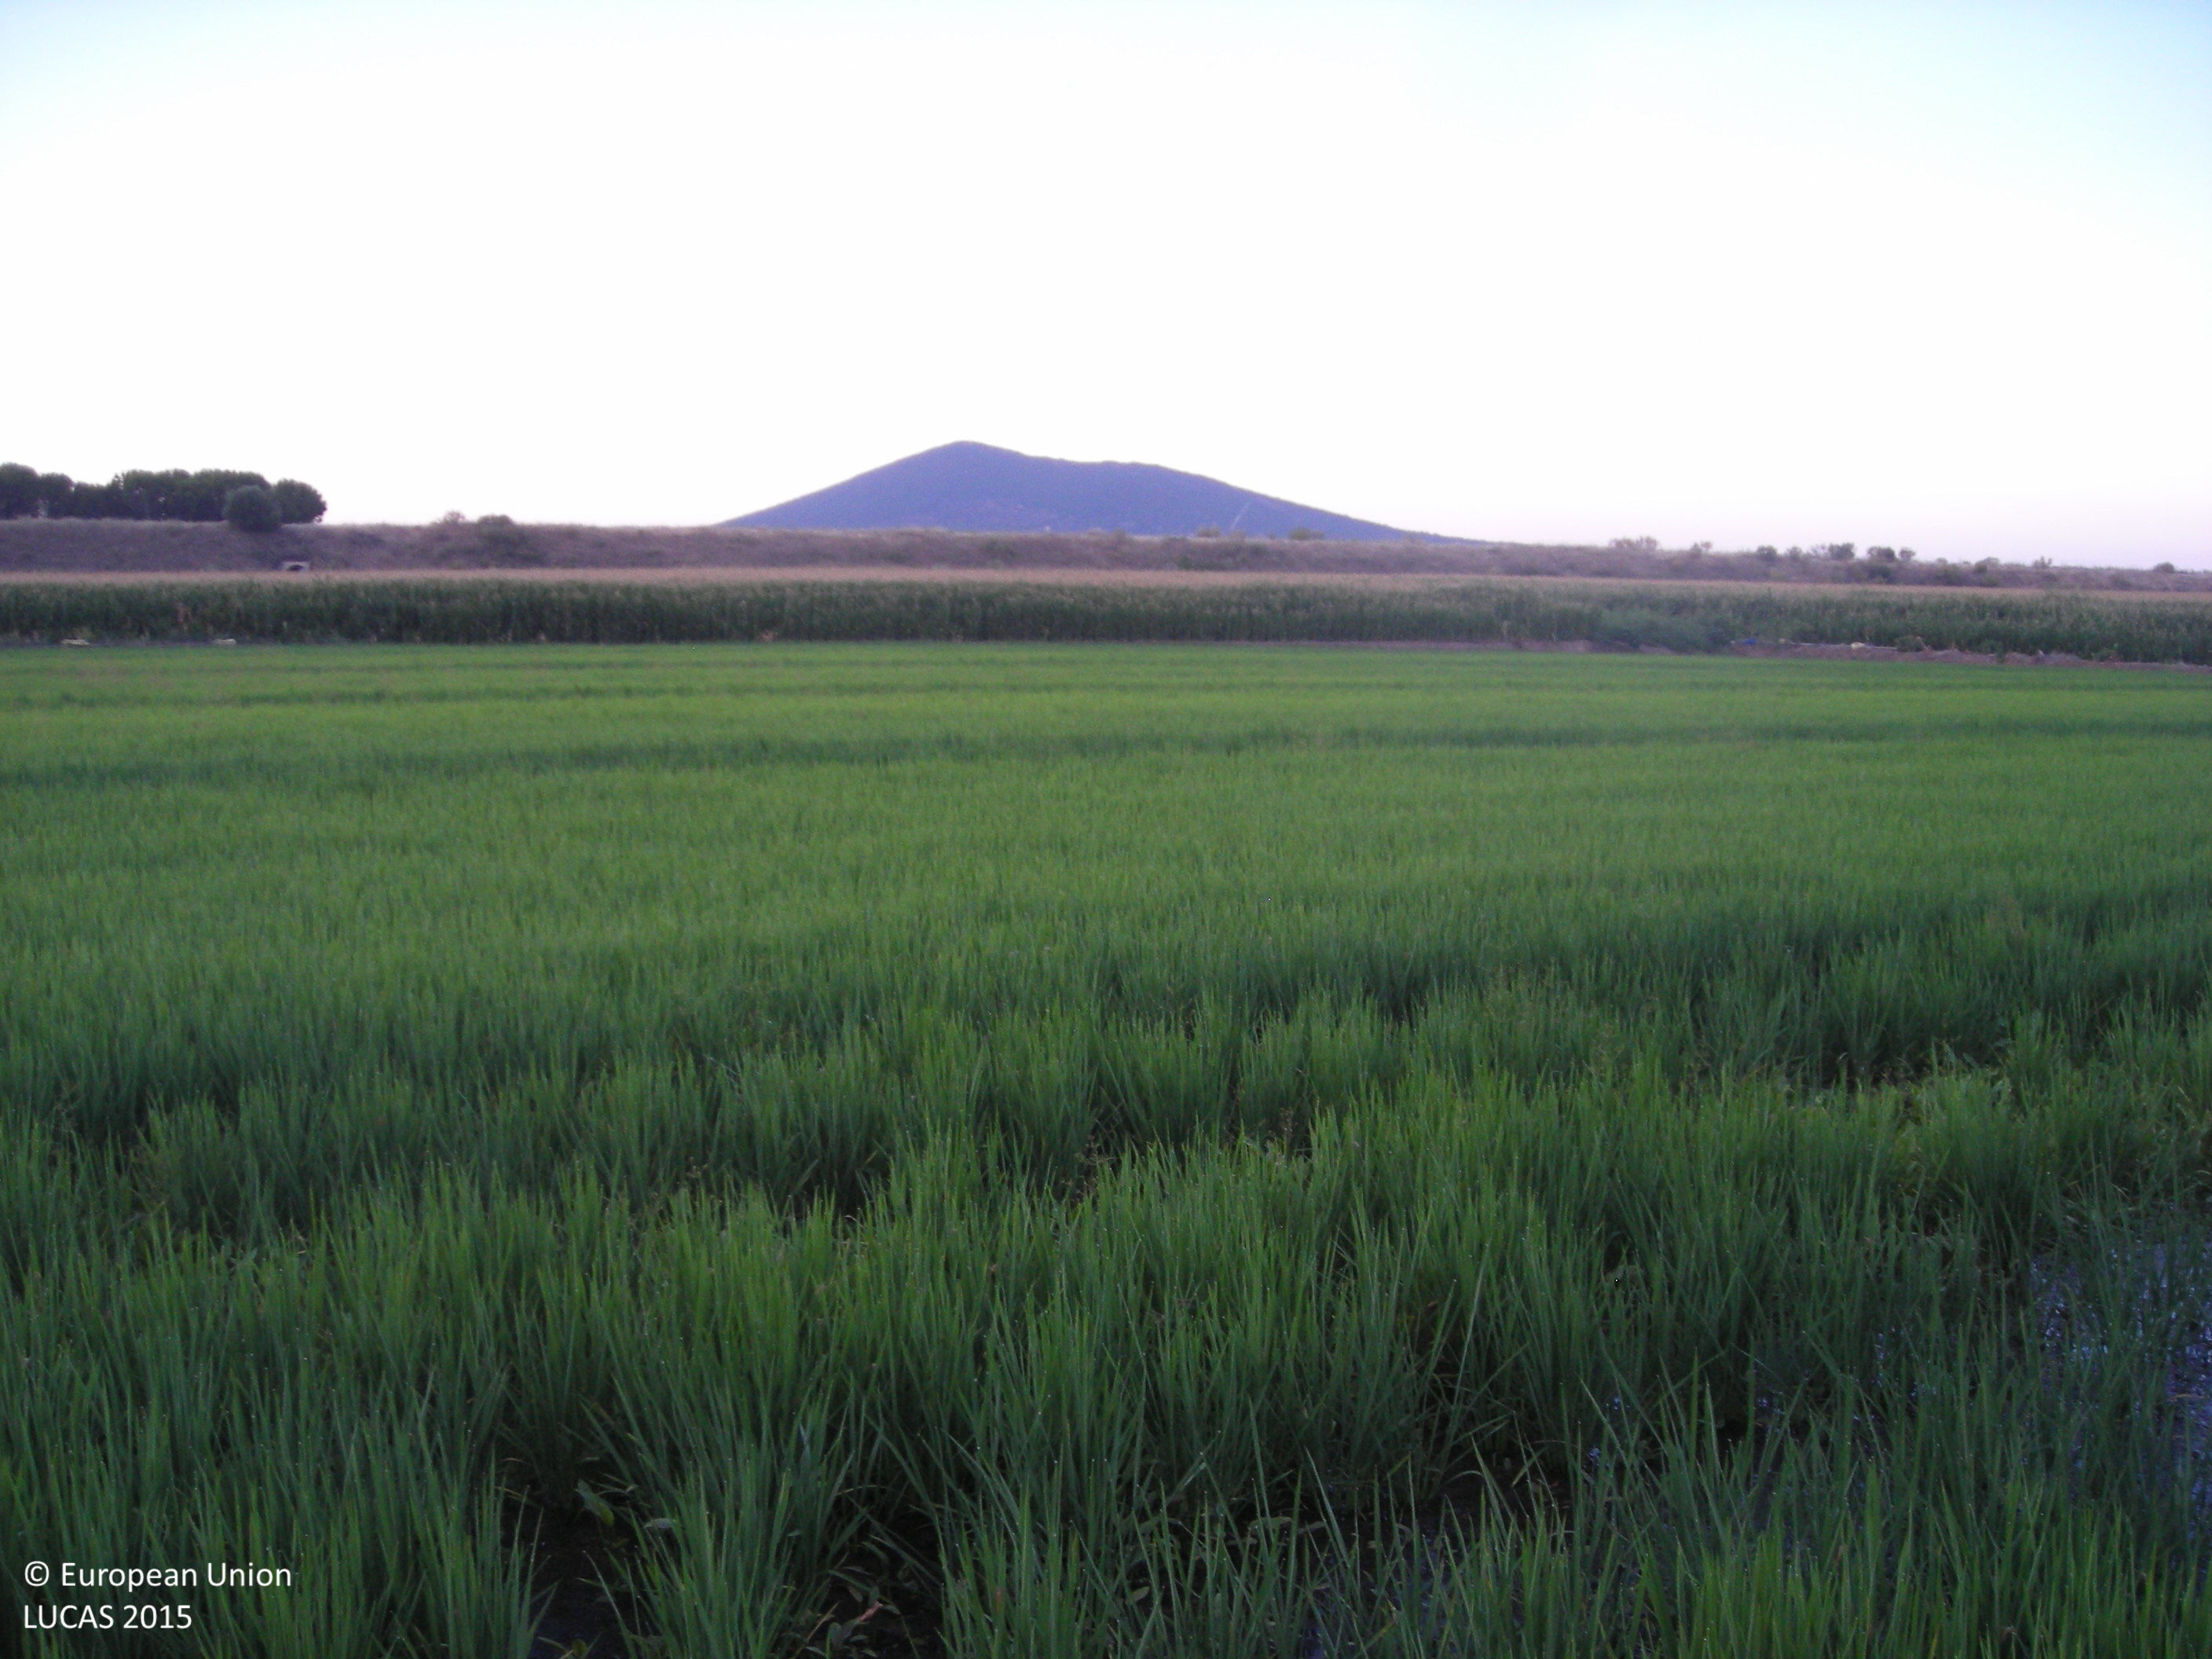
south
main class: Cropland
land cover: Rice
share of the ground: > 75 %
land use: Agriculture (excluding fallow land and kitchen gardens)
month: July
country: ES
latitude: 38.9230
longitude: -5.9092
